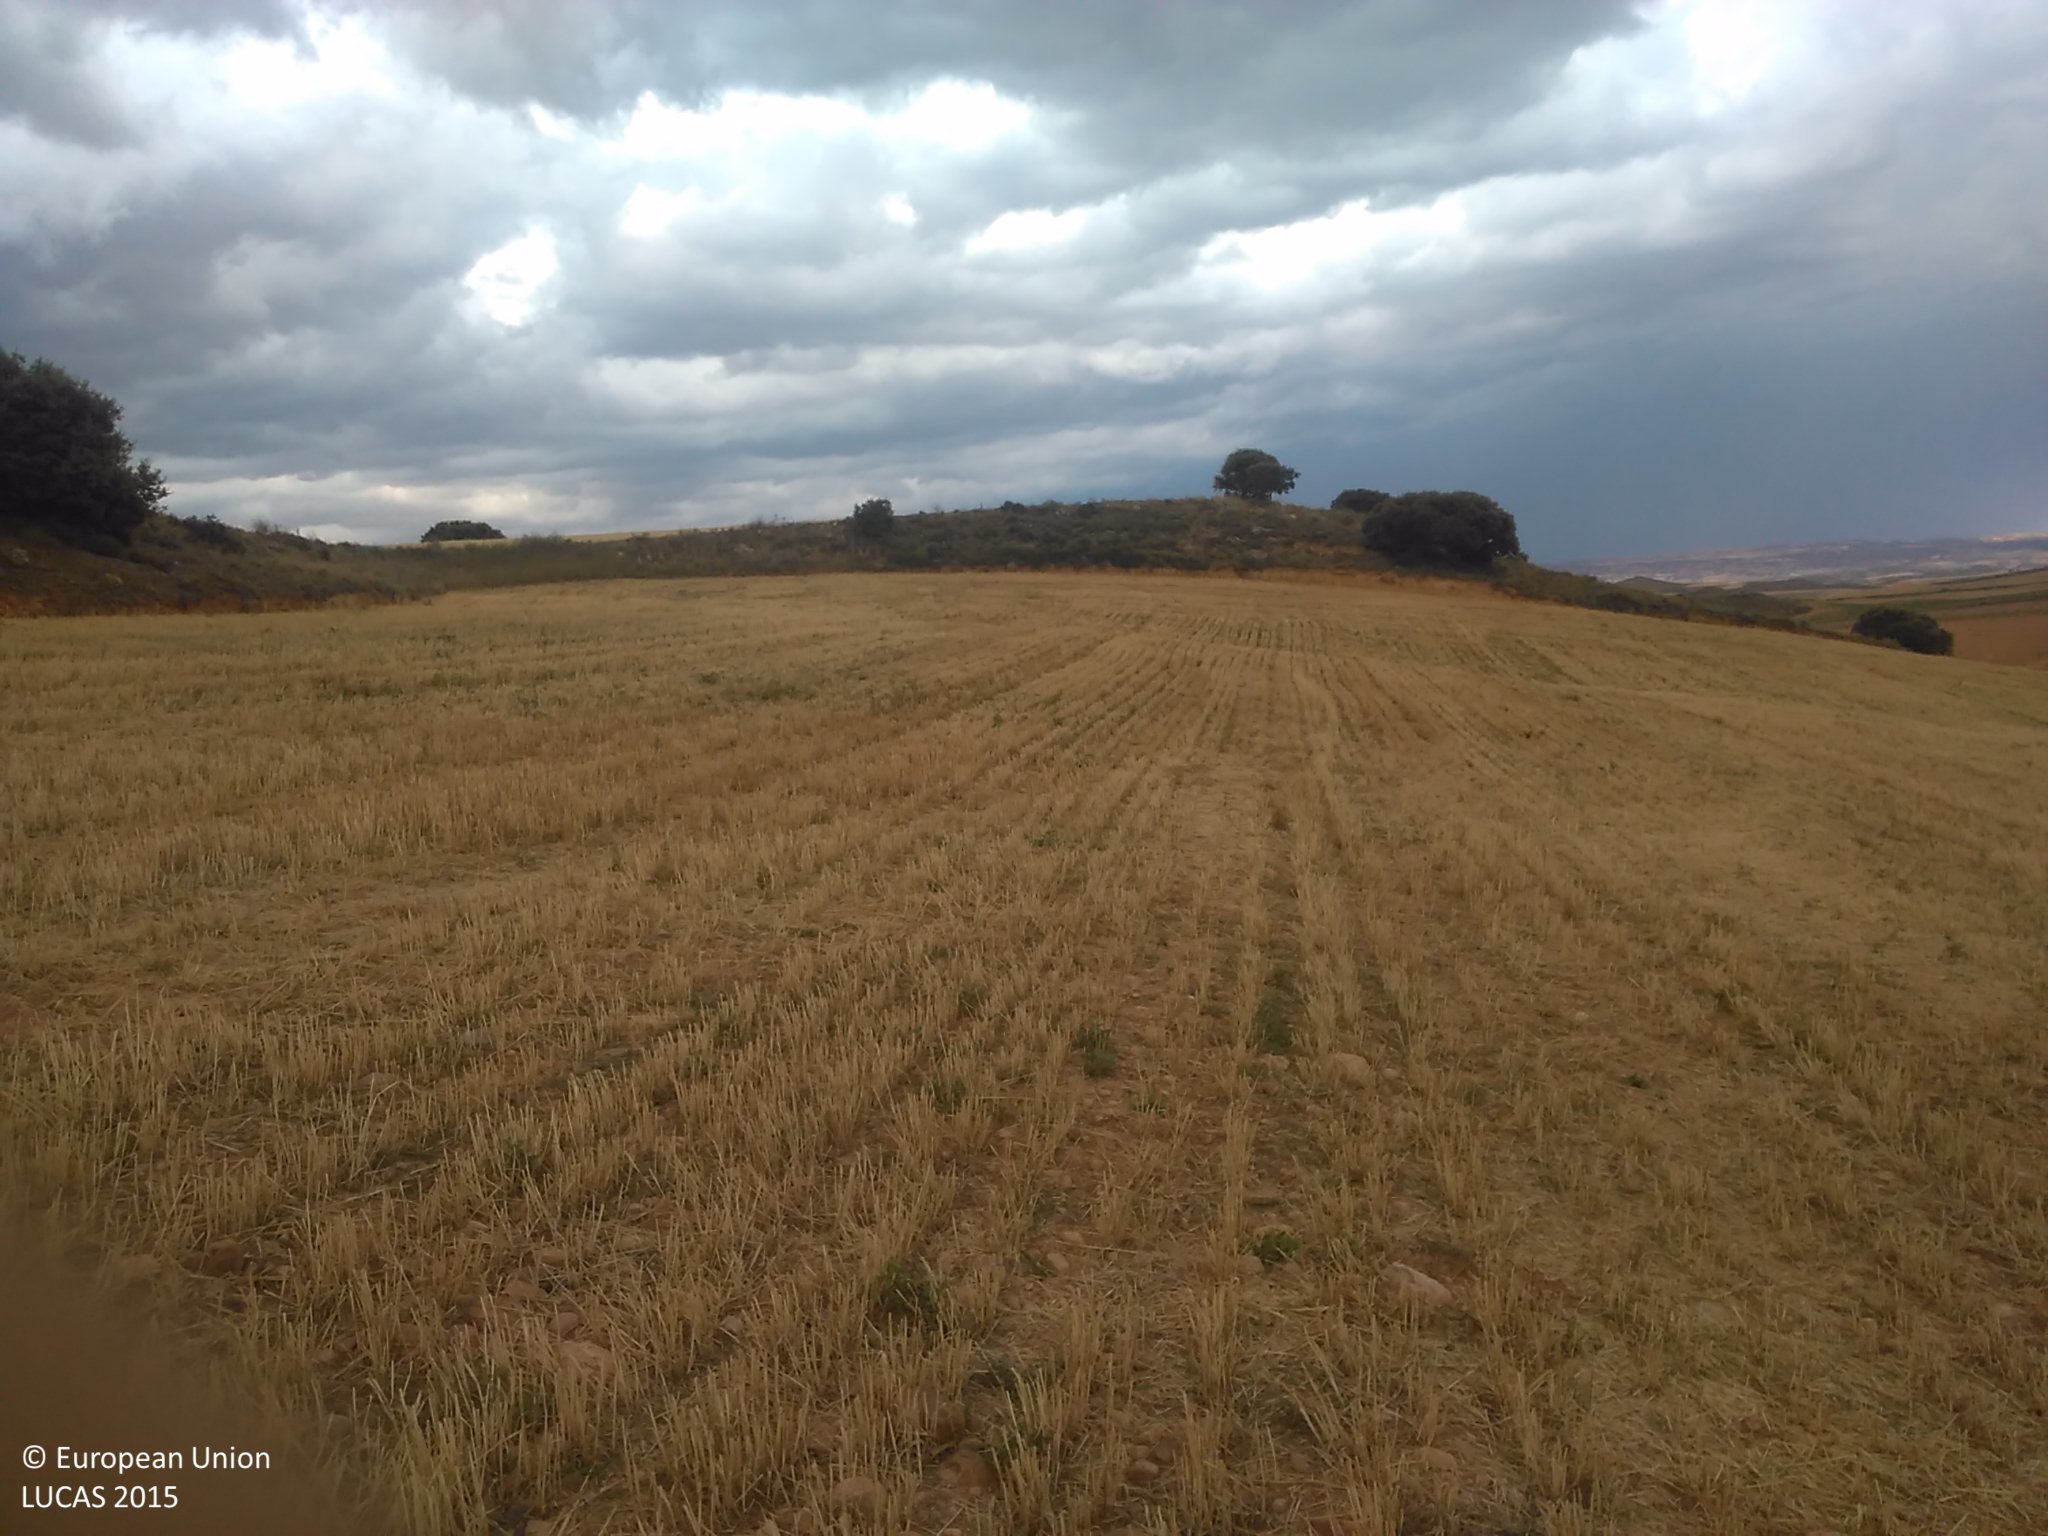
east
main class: Cropland
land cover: Barley
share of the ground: < 10 %
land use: Agriculture (excluding fallow land and kitchen gardens)
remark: Harvested field
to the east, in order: Barley; Shrubland without tree cover; Barley; Shrubland without tree cover; Barley; Shrubland without tree cover; Grassland without tree/shrub cover; Barley
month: July
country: ES
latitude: 41.4536
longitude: -2.2305
